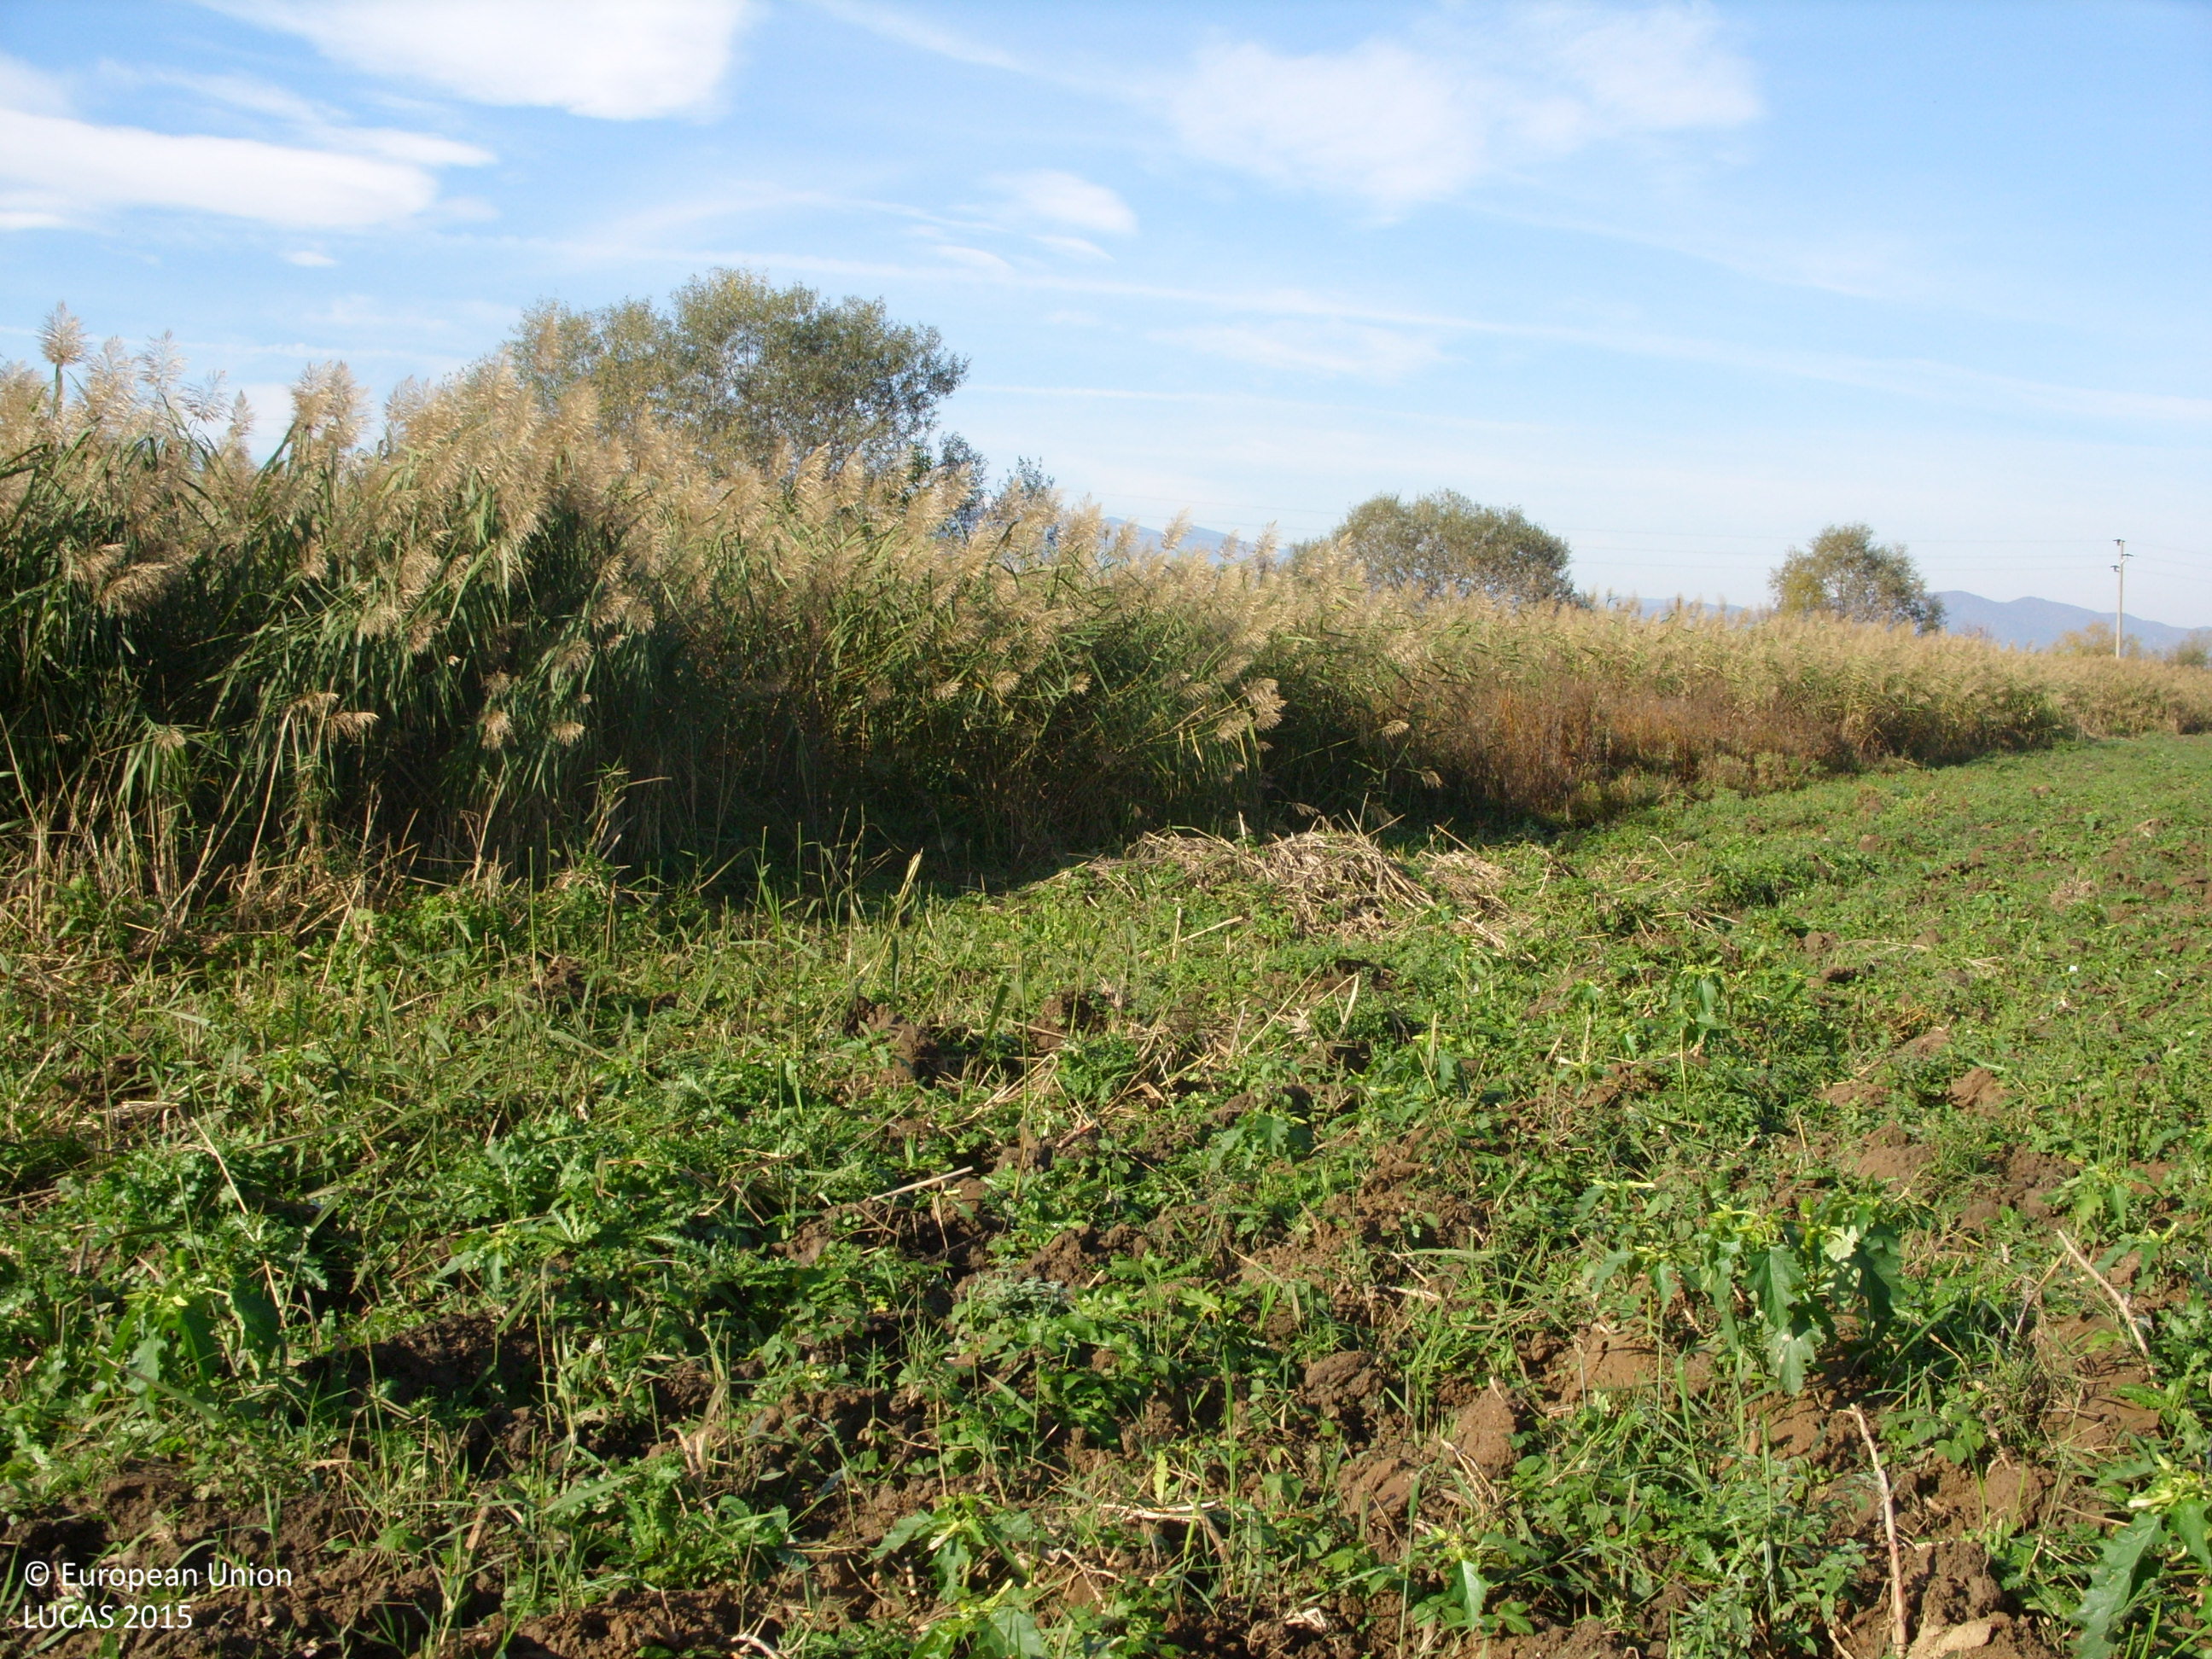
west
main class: Cropland
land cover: Barley
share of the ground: < 10 %
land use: Agriculture (excluding fallow land and kitchen gardens)
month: October
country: BG
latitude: 42.2216
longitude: 24.1560
